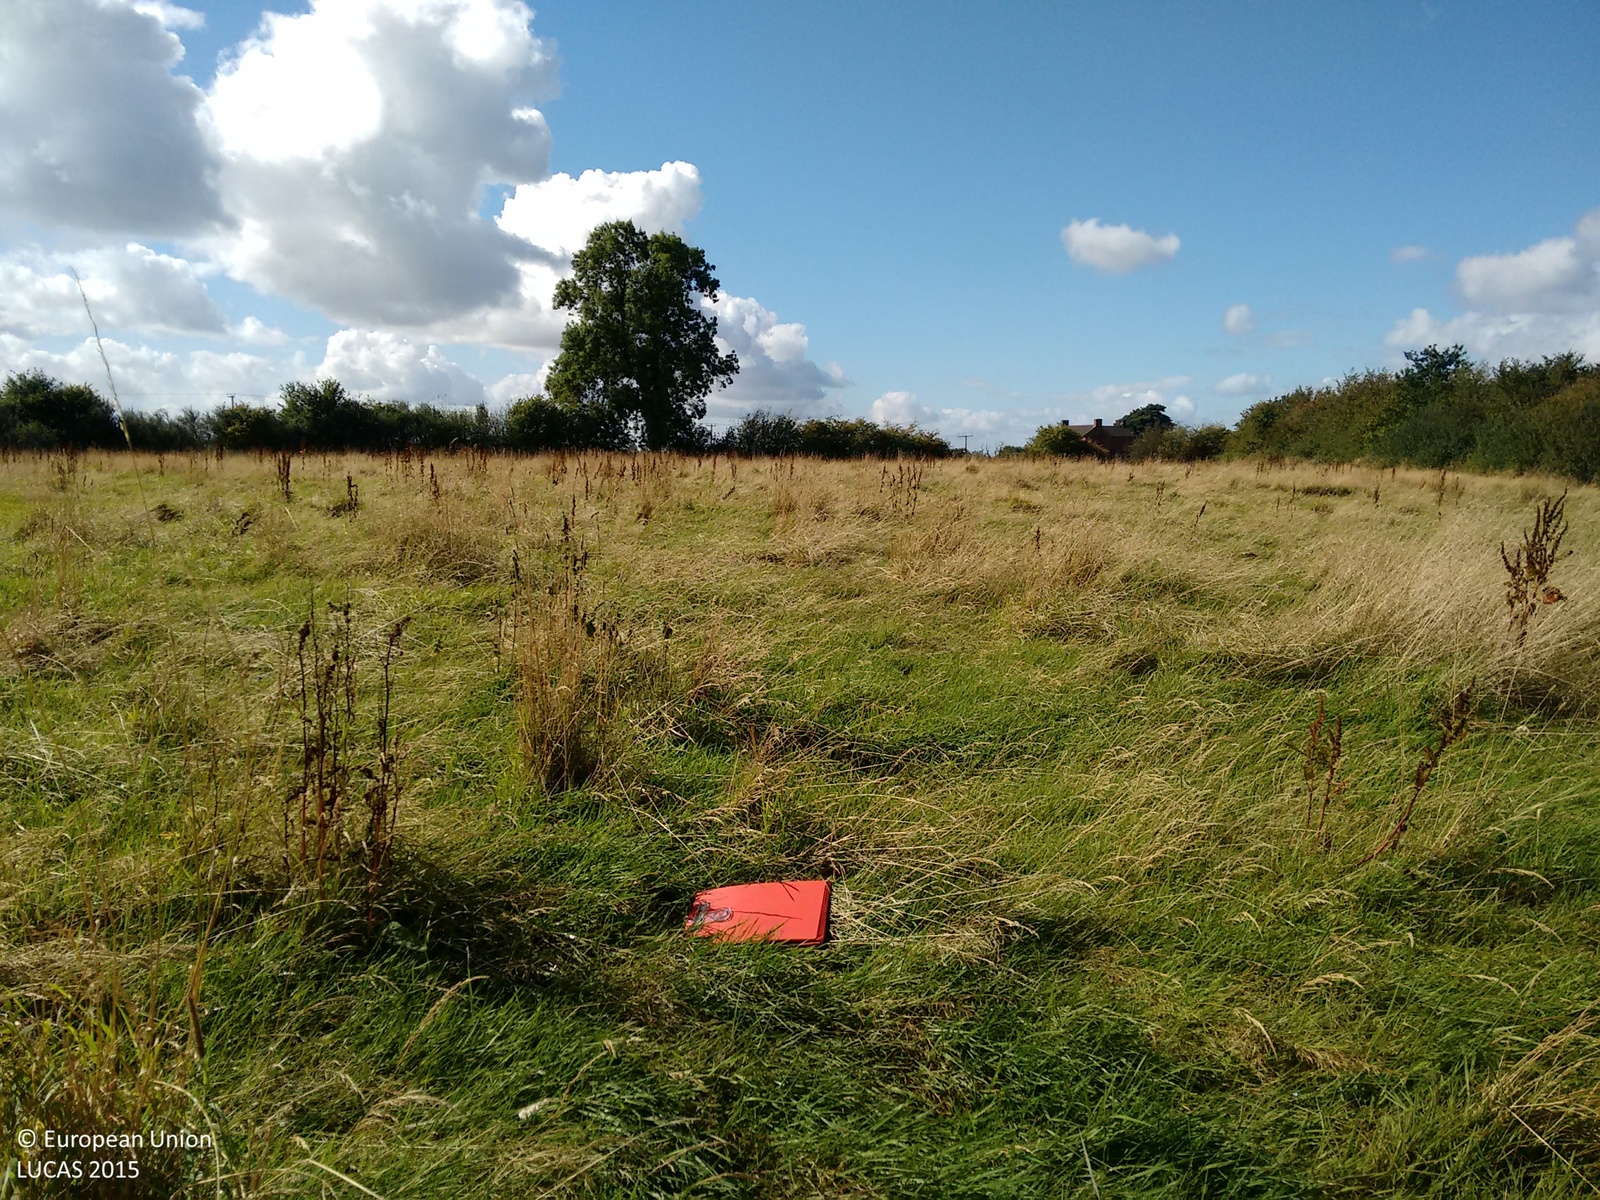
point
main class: Grassland
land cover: Grassland without tree/shrub cover
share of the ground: > 75 %
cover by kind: herbaceous plants 100 %
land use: Agriculture (excluding fallow land and kitchen gardens)
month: September
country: GB
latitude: 52.9029
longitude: -2.0870
